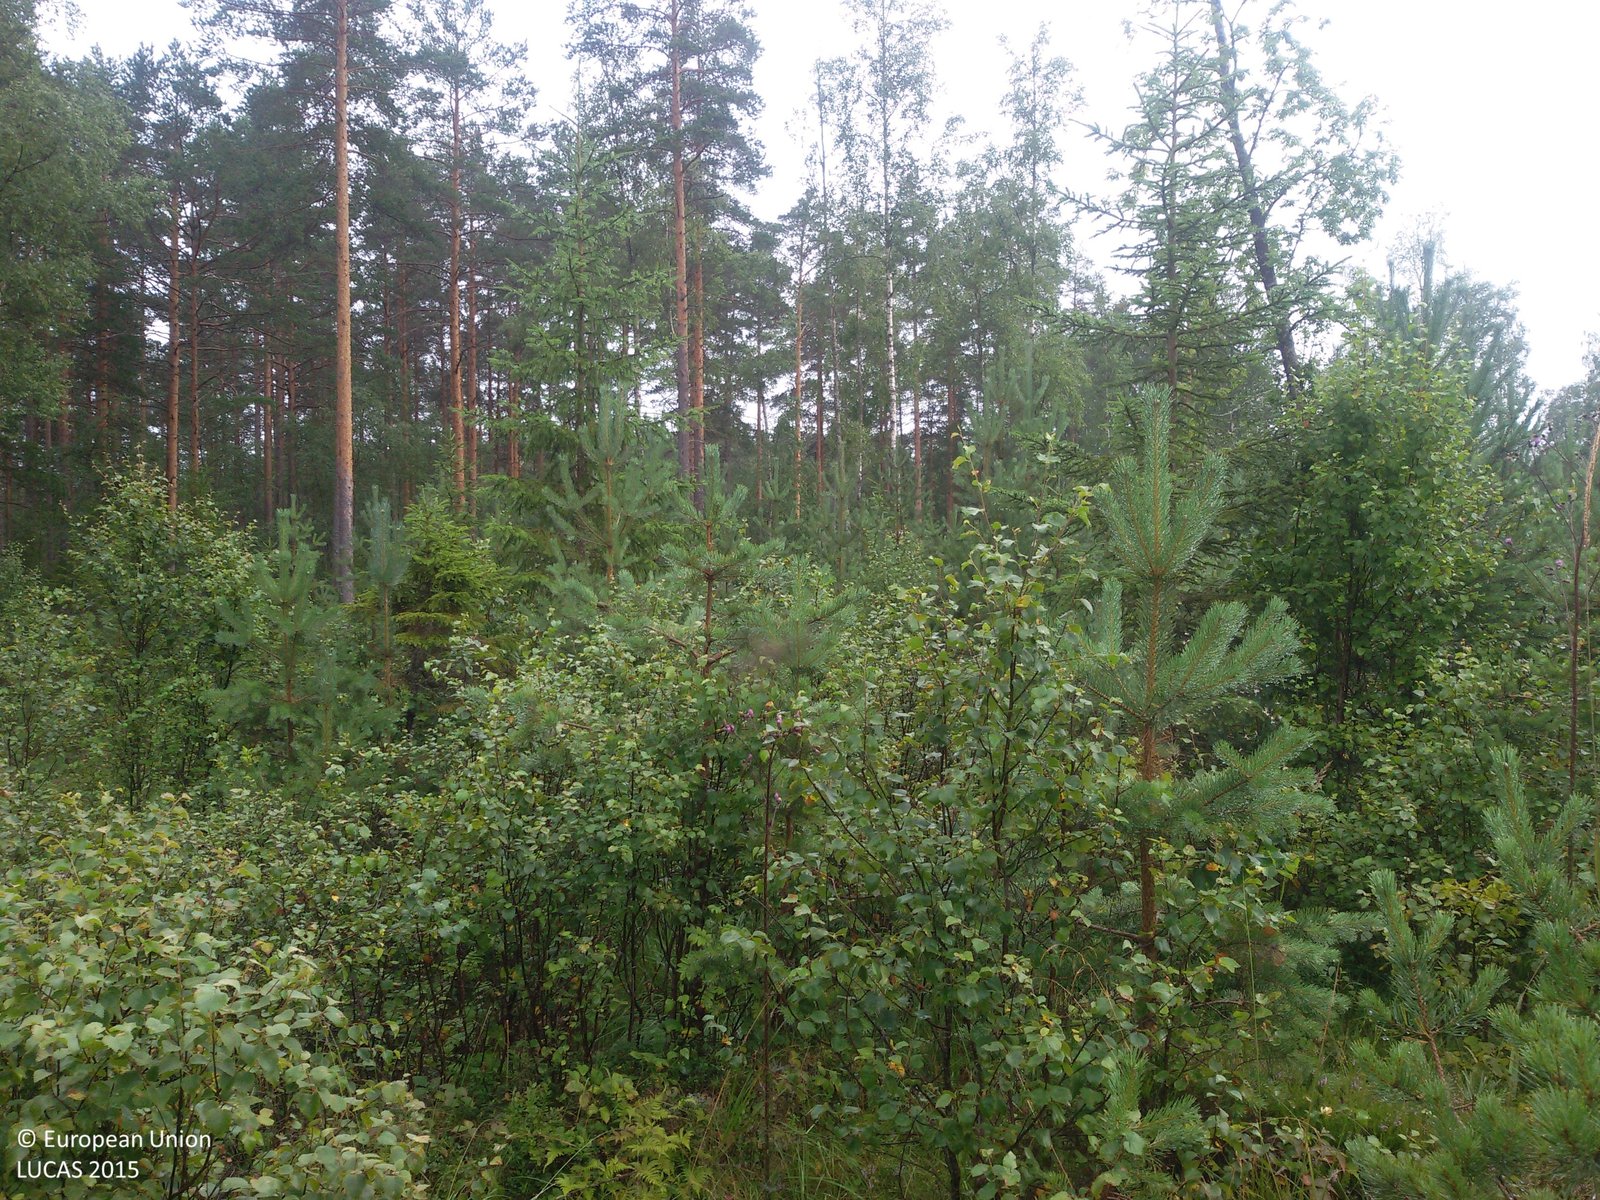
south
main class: Woodland
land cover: Pine dominated mixed woodland
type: boreal forest
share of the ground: > 75 %
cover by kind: coniferous forest trees 40 %, broadleaved forest trees 40 %, herbaceous plants 20 %
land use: Forestry
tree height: < 5 m
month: August
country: SE
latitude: 60.7666
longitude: 16.6142
